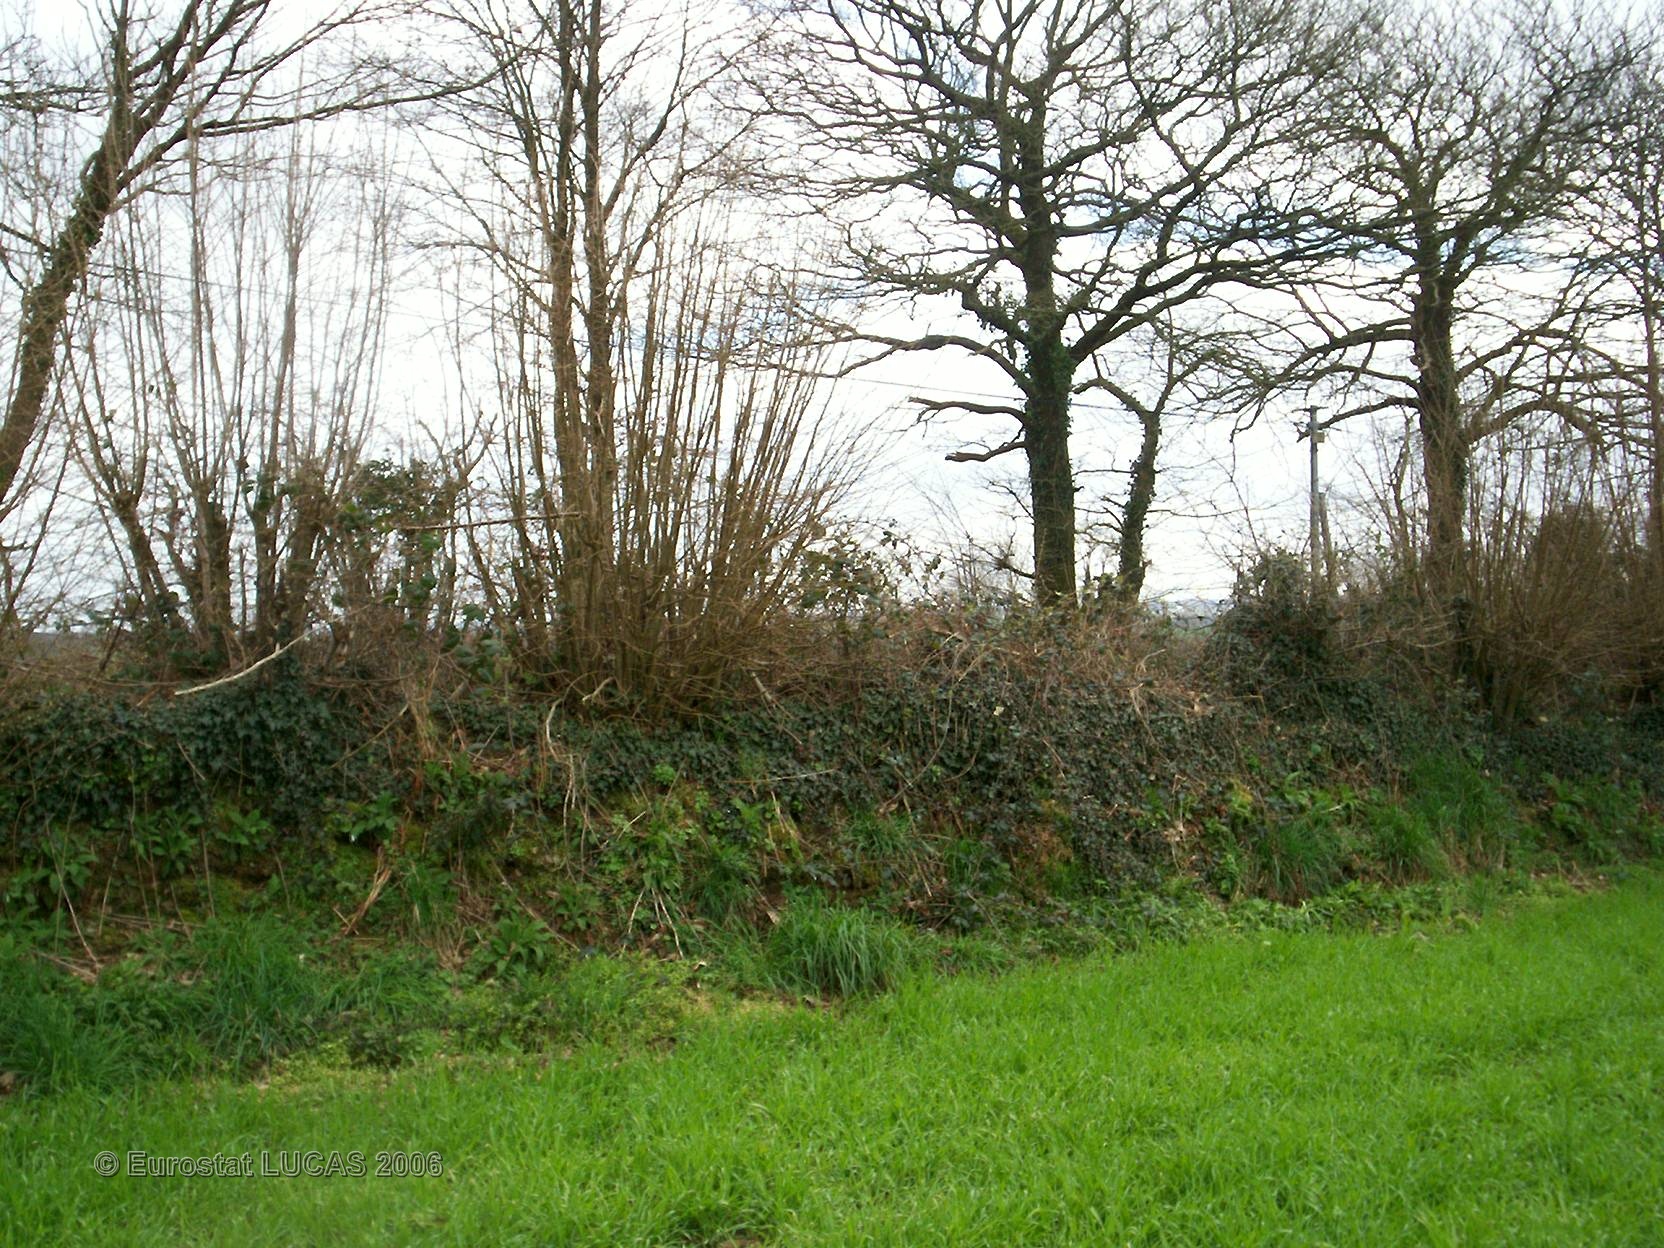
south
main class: Cropland
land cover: Barley
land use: Agriculture (excluding fallow land and kitchen gardens)
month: April
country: FR
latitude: 48.1053
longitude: -3.6030
